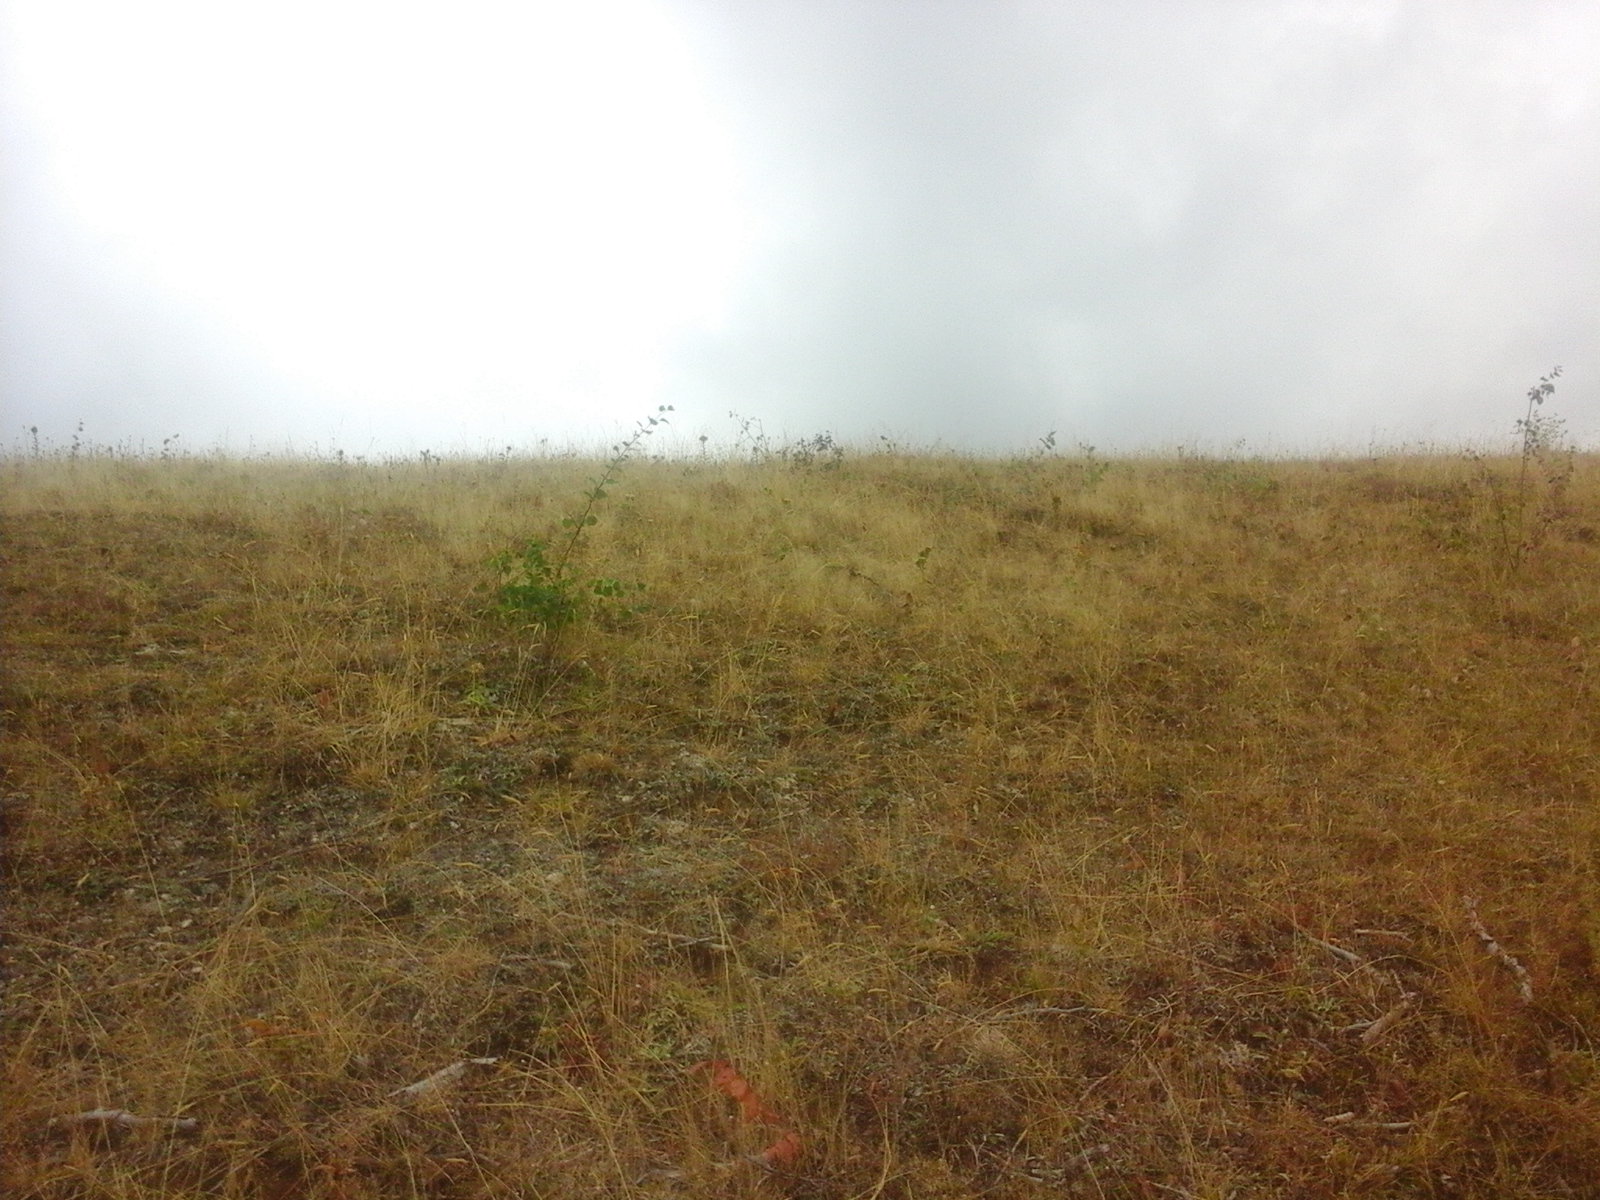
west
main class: Woodland
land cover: Broadleaved woodland
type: acidophilous oak and oak-birch forest
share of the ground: > 75 %
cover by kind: broadleaved forest trees 100 %
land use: Forestry
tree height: > 5 m
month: August
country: RO
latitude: 44.9395
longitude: 22.8072
